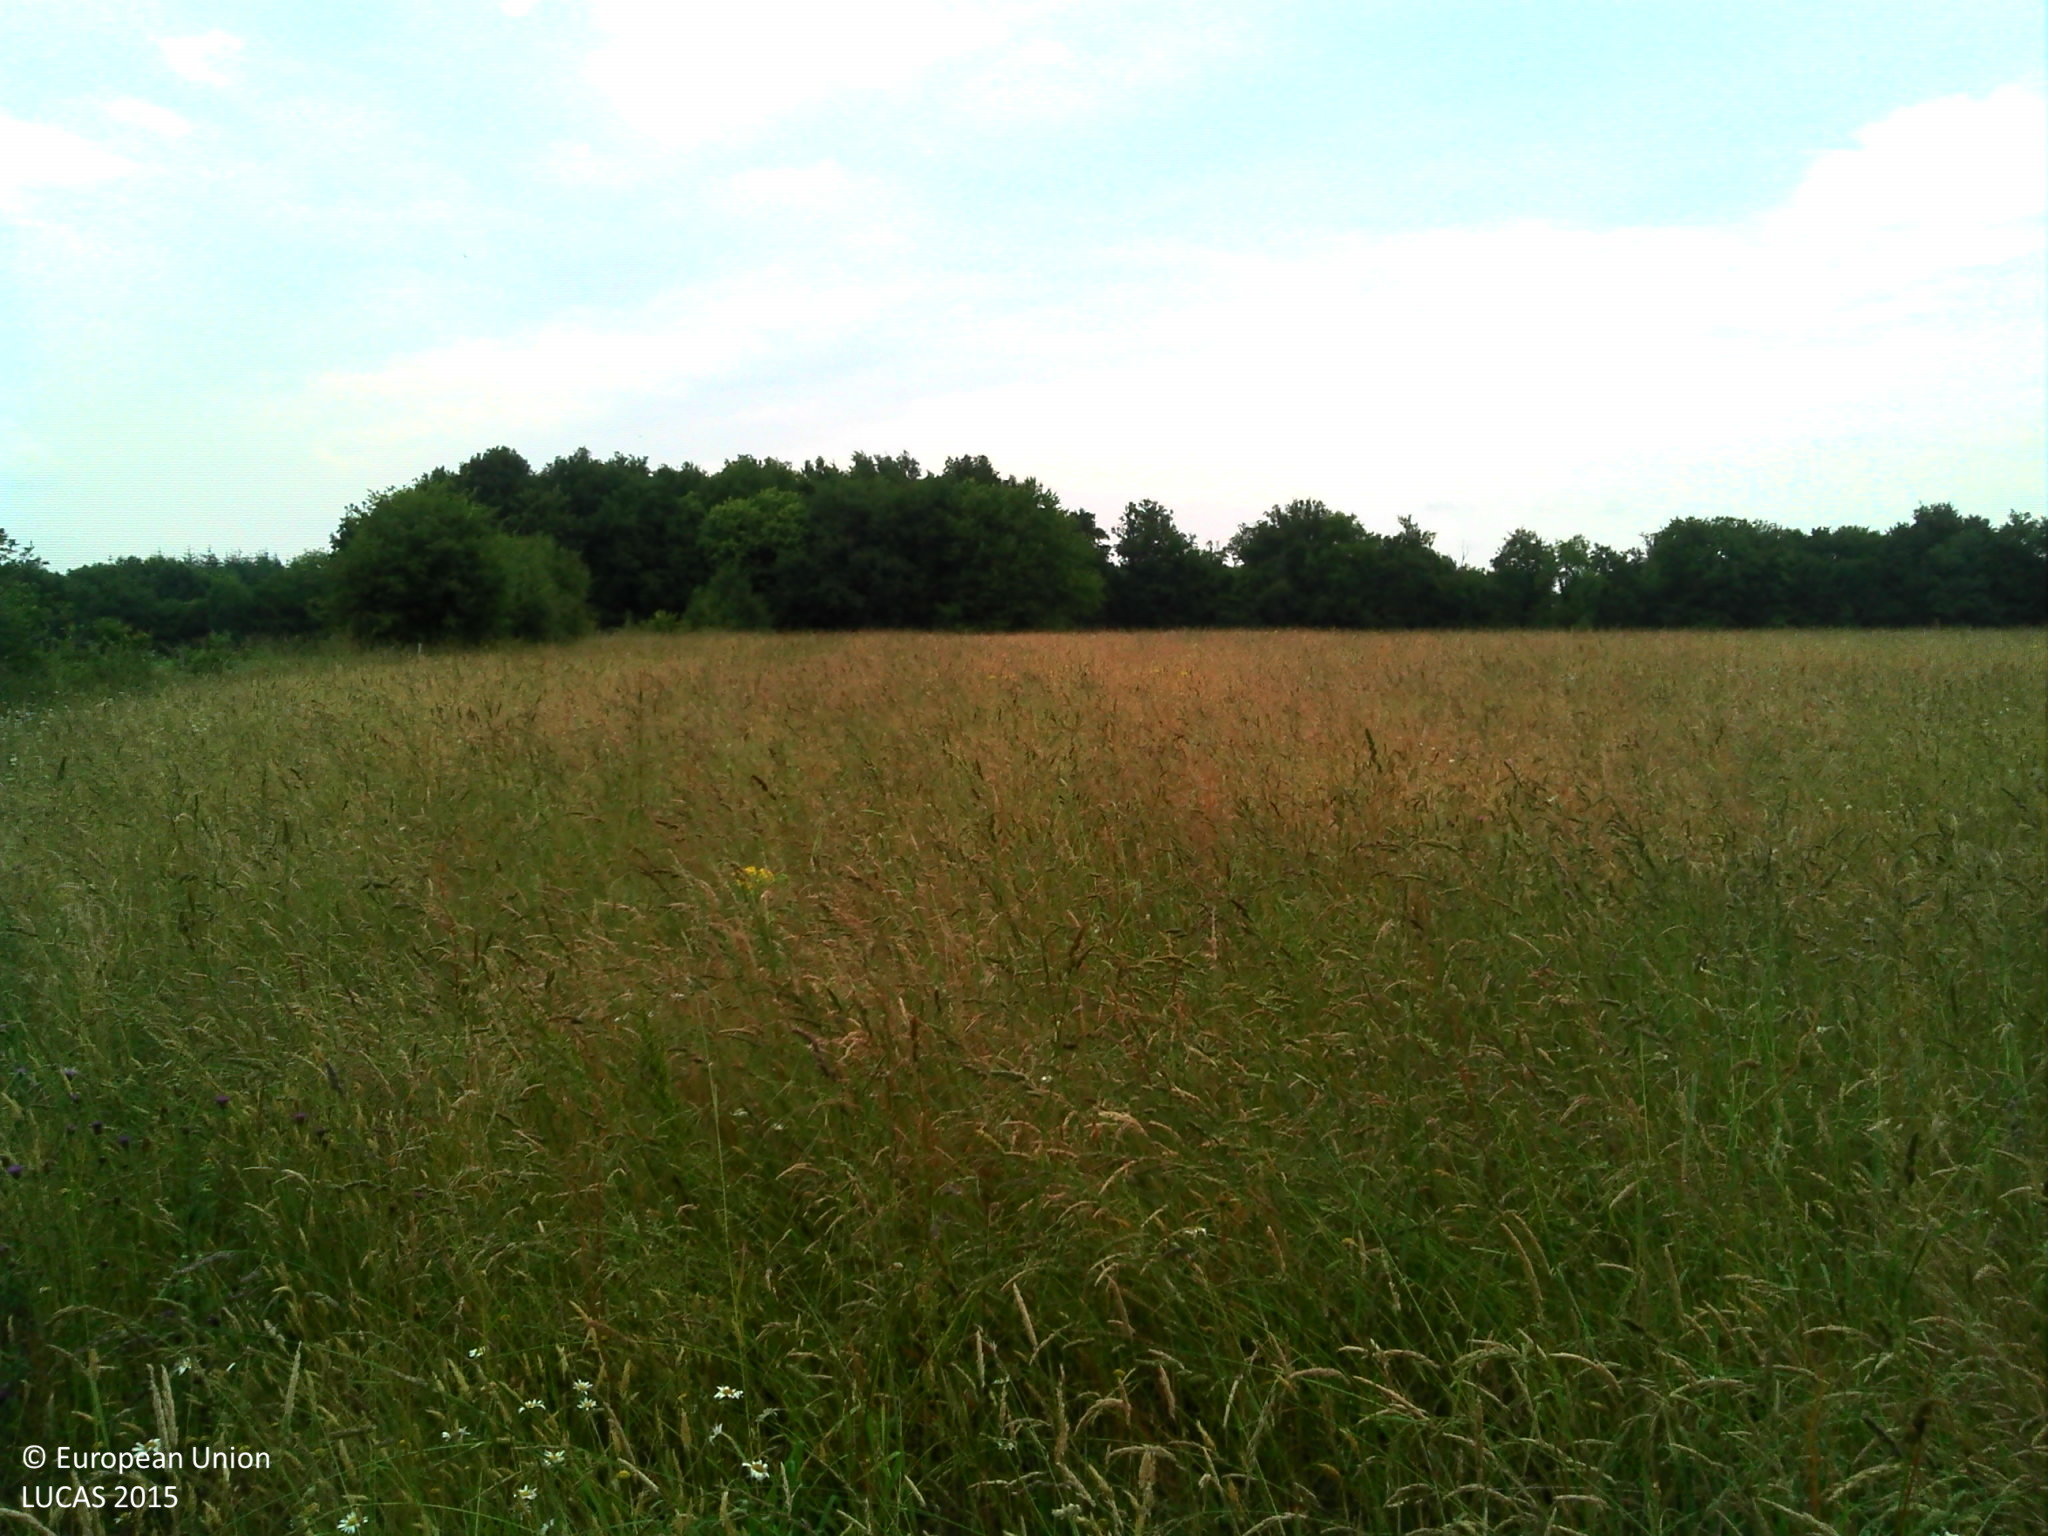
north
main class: Grassland
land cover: Grassland without tree/shrub cover
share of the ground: > 75 %
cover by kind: herbaceous plants 100 %
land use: Agriculture (excluding fallow land and kitchen gardens)
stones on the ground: < 10 %
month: June
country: FR
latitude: 45.9505
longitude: 0.5548
